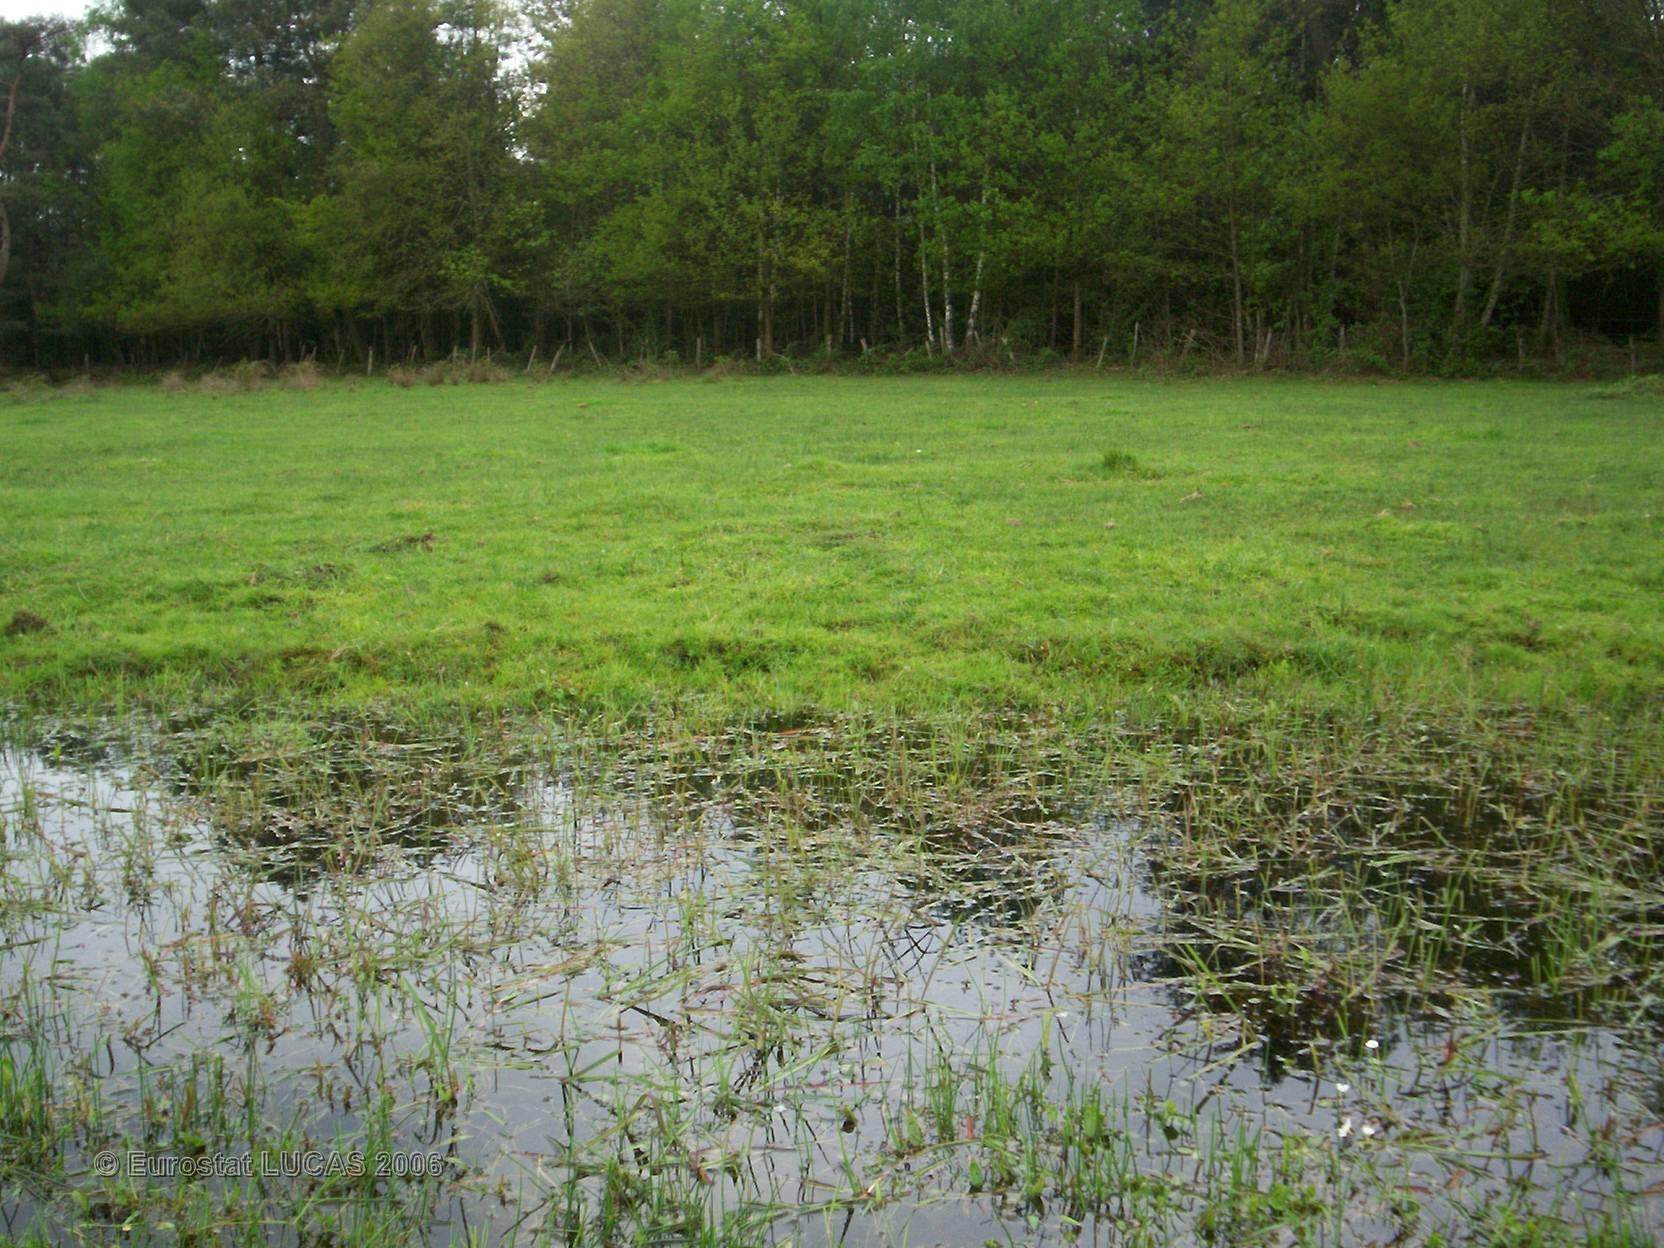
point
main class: Grassland
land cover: Grassland without tree/shrub cover
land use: Agriculture (excluding fallow land and kitchen gardens)
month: May
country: FR
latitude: 47.9573
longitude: 0.2929
